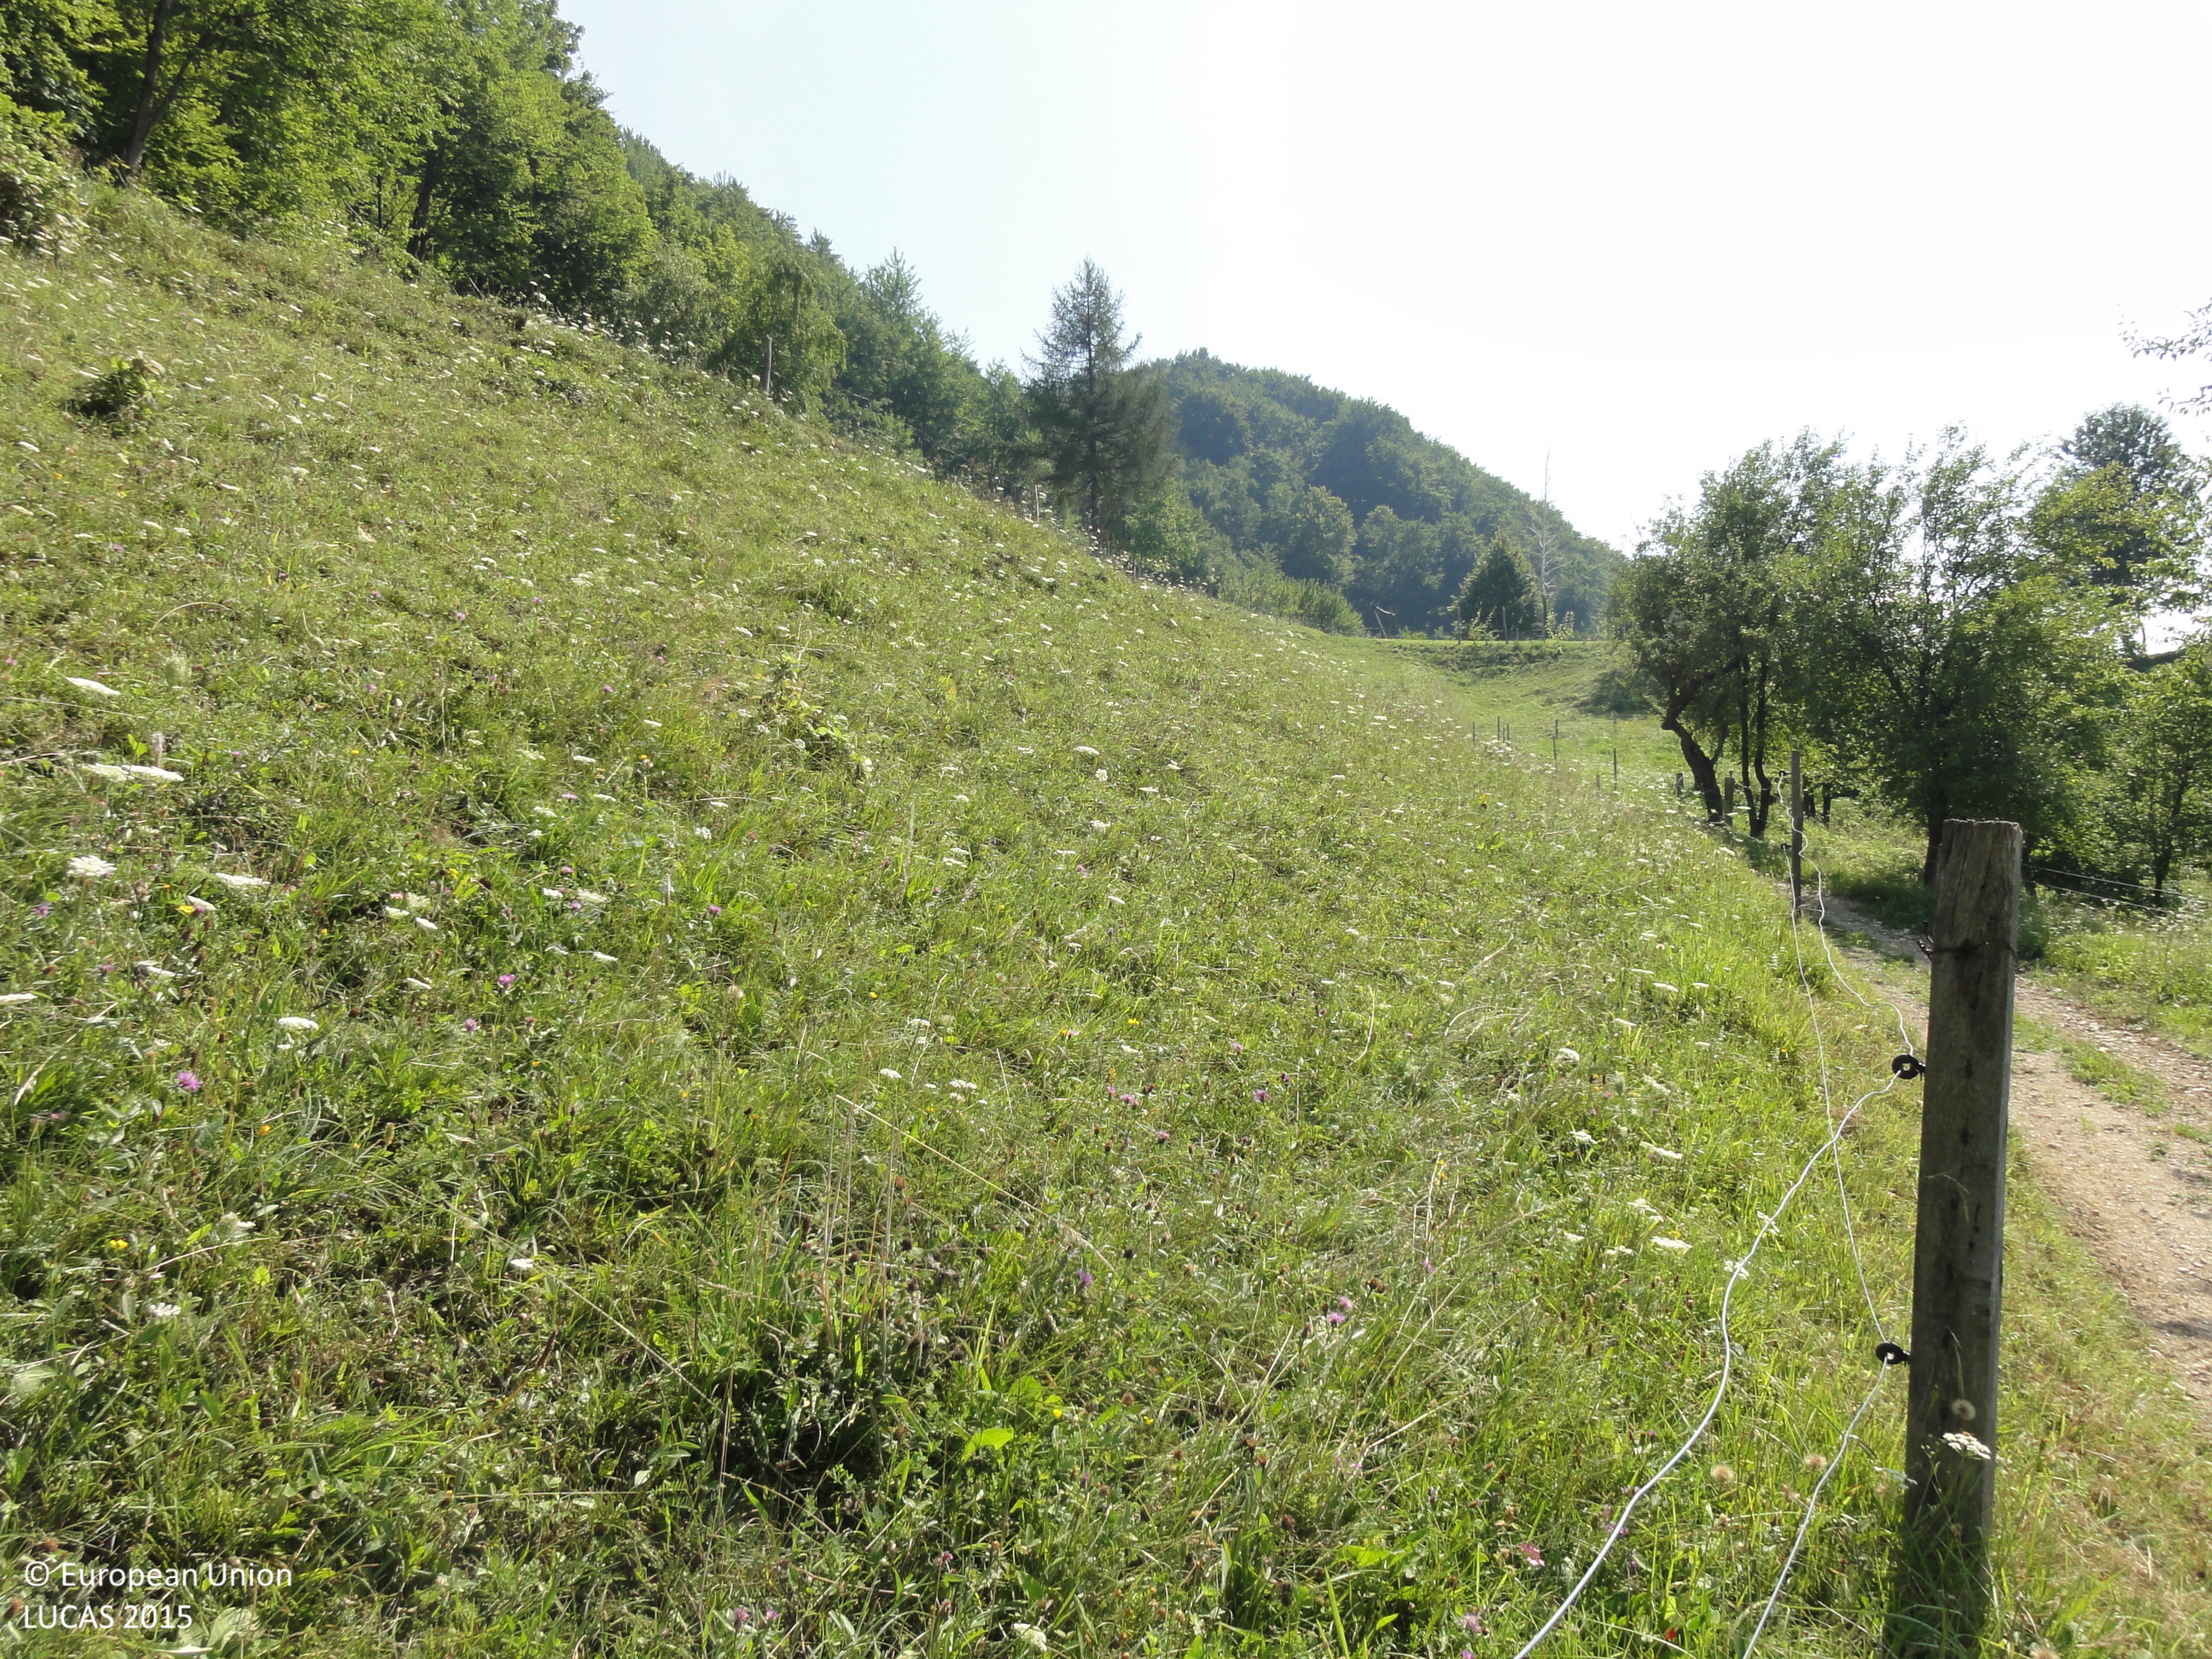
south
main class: Grassland
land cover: Grassland without tree/shrub cover
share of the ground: > 75 %
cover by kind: herbaceous plants 100 %
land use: Agriculture (excluding fallow land and kitchen gardens)
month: August
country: SI
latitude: 46.1568
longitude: 15.4753
